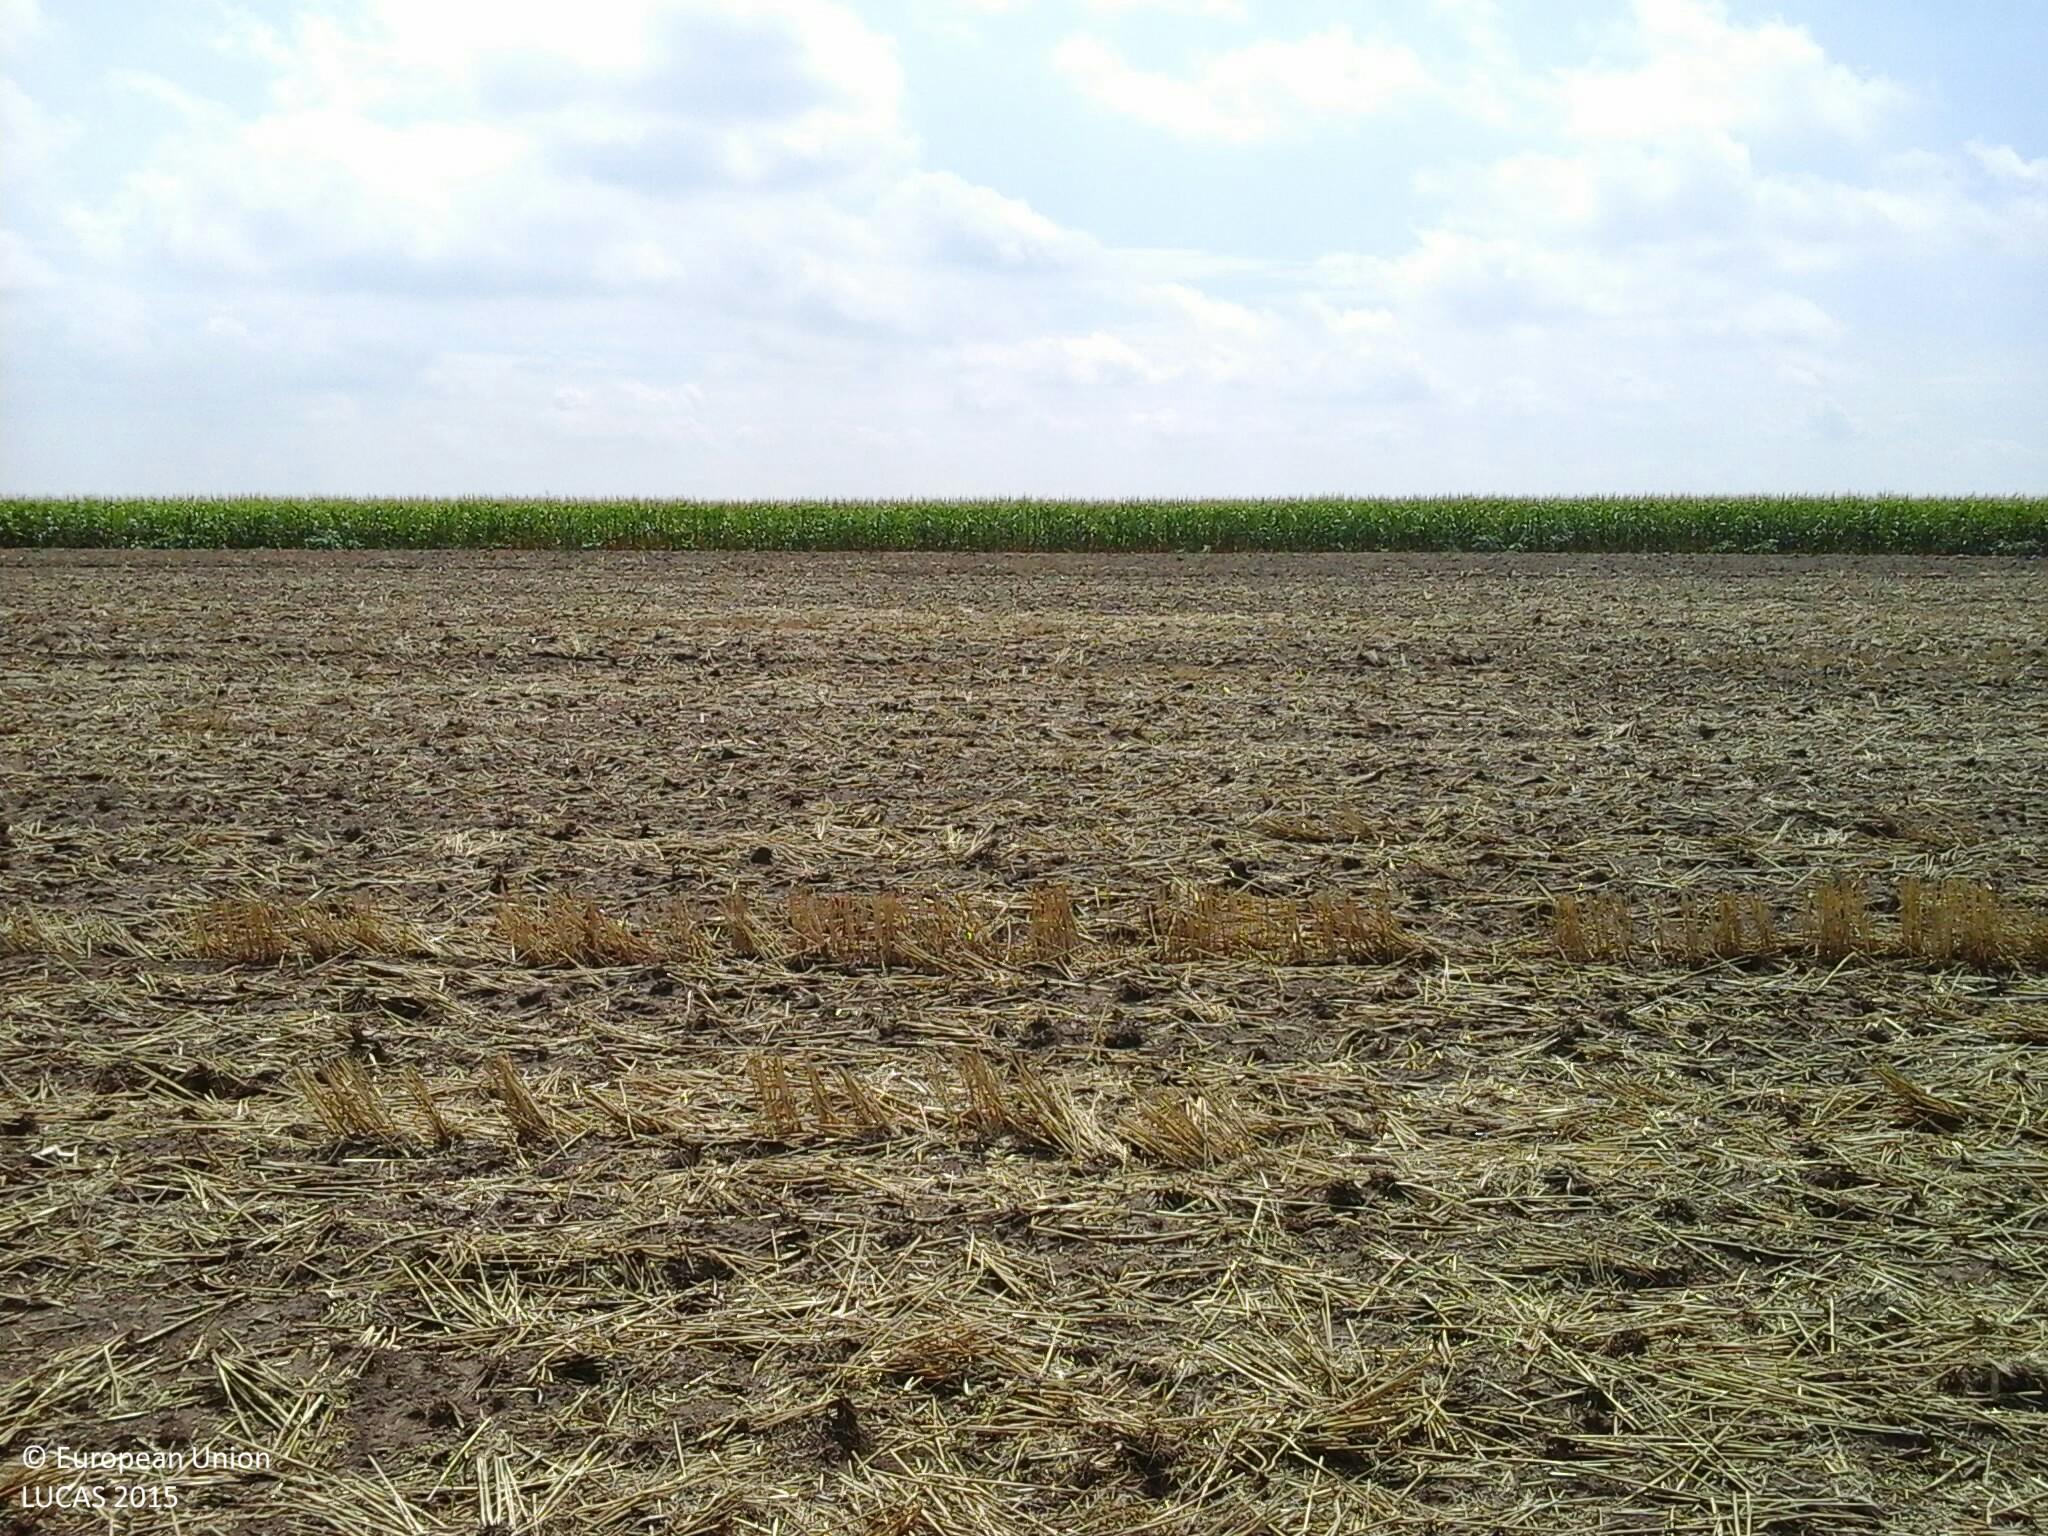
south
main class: Cropland
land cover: Common wheat
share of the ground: 10 - 25 %
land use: Agriculture (excluding fallow land and kitchen gardens)
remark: Harvested field
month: July
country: HU
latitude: 47.8997
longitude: 21.4274
